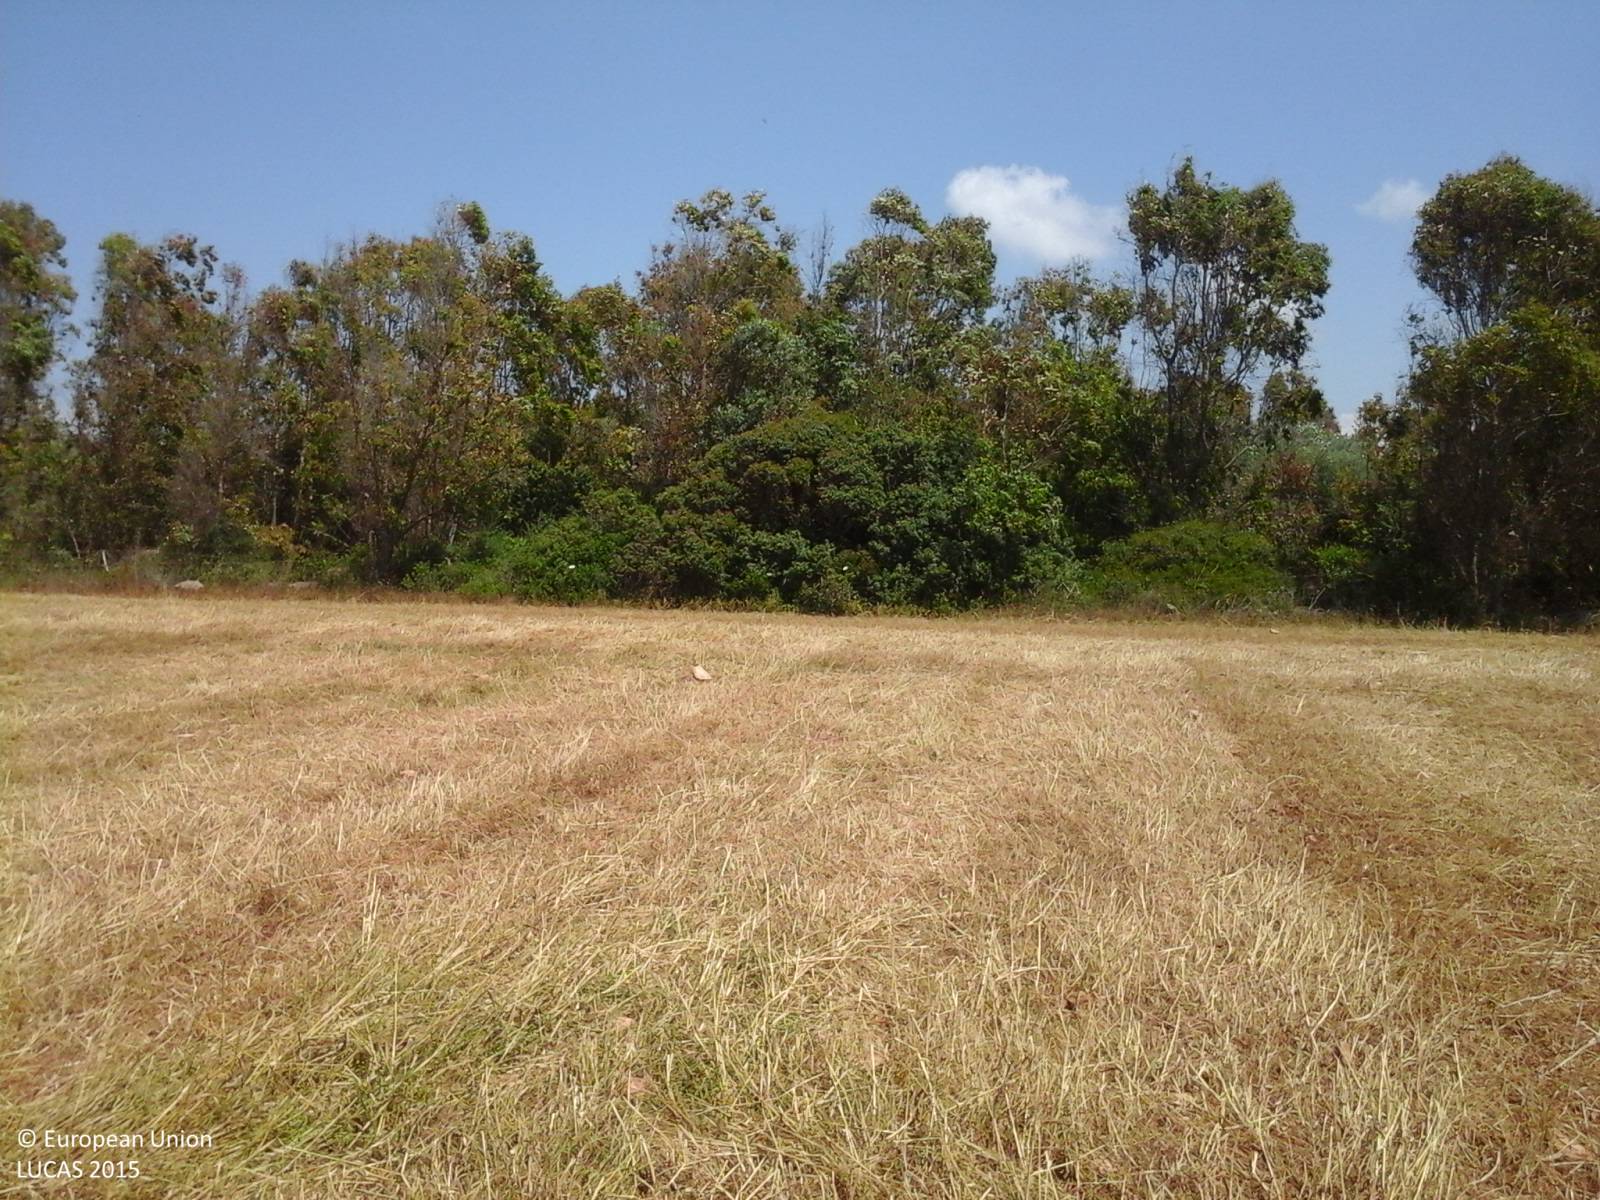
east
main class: Grassland
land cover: Grassland without tree/shrub cover
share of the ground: > 75 %
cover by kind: herbaceous plants 100 %
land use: Agriculture (excluding fallow land and kitchen gardens)
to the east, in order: Grassland without tree/shrub cover; Fences; Broadleaved woodland; Olive groves; Paved roads, cycling and walking lanes; Broadleaved woodland; Olive groves; Grassland without tree/shrub cover; Fences; Durum wheat
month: May
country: IT
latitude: 40.7605
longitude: 8.3613
